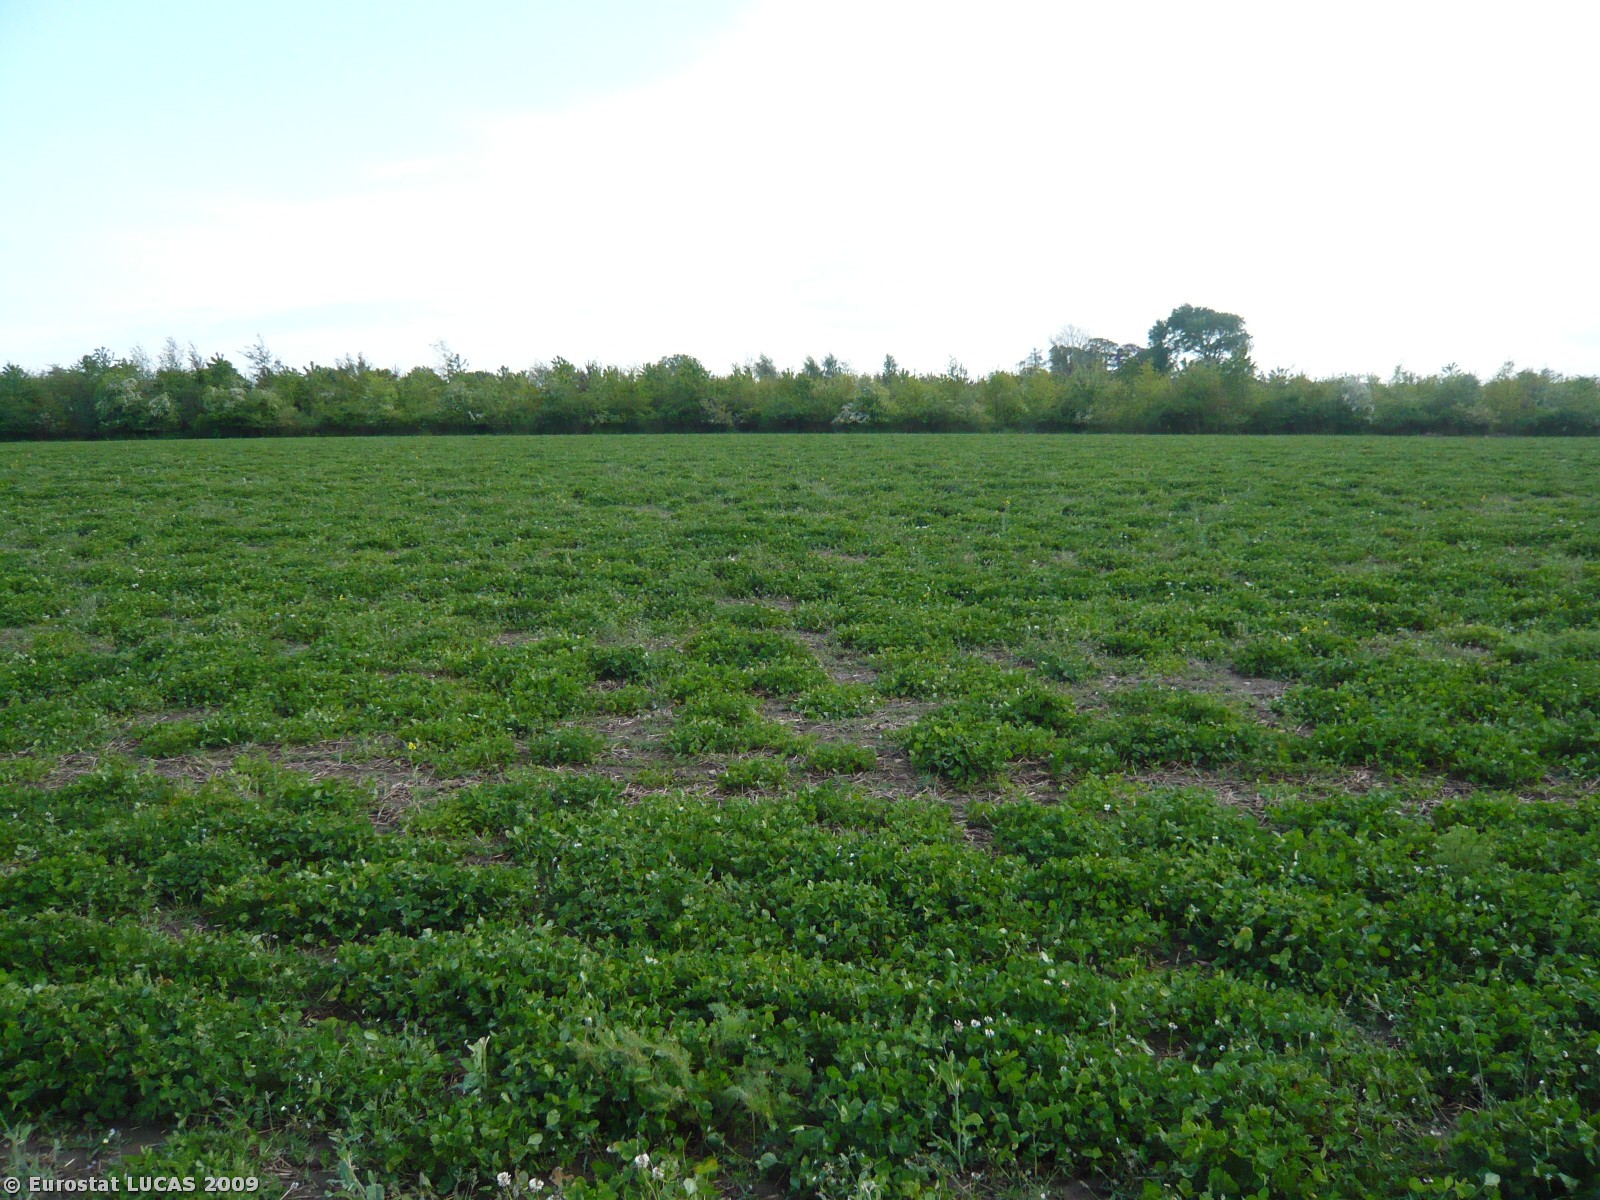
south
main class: Cropland
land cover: Clovers
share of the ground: > 75 %
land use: Agriculture (excluding fallow land and kitchen gardens)
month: May
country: DK
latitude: 55.4023
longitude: 11.7830
